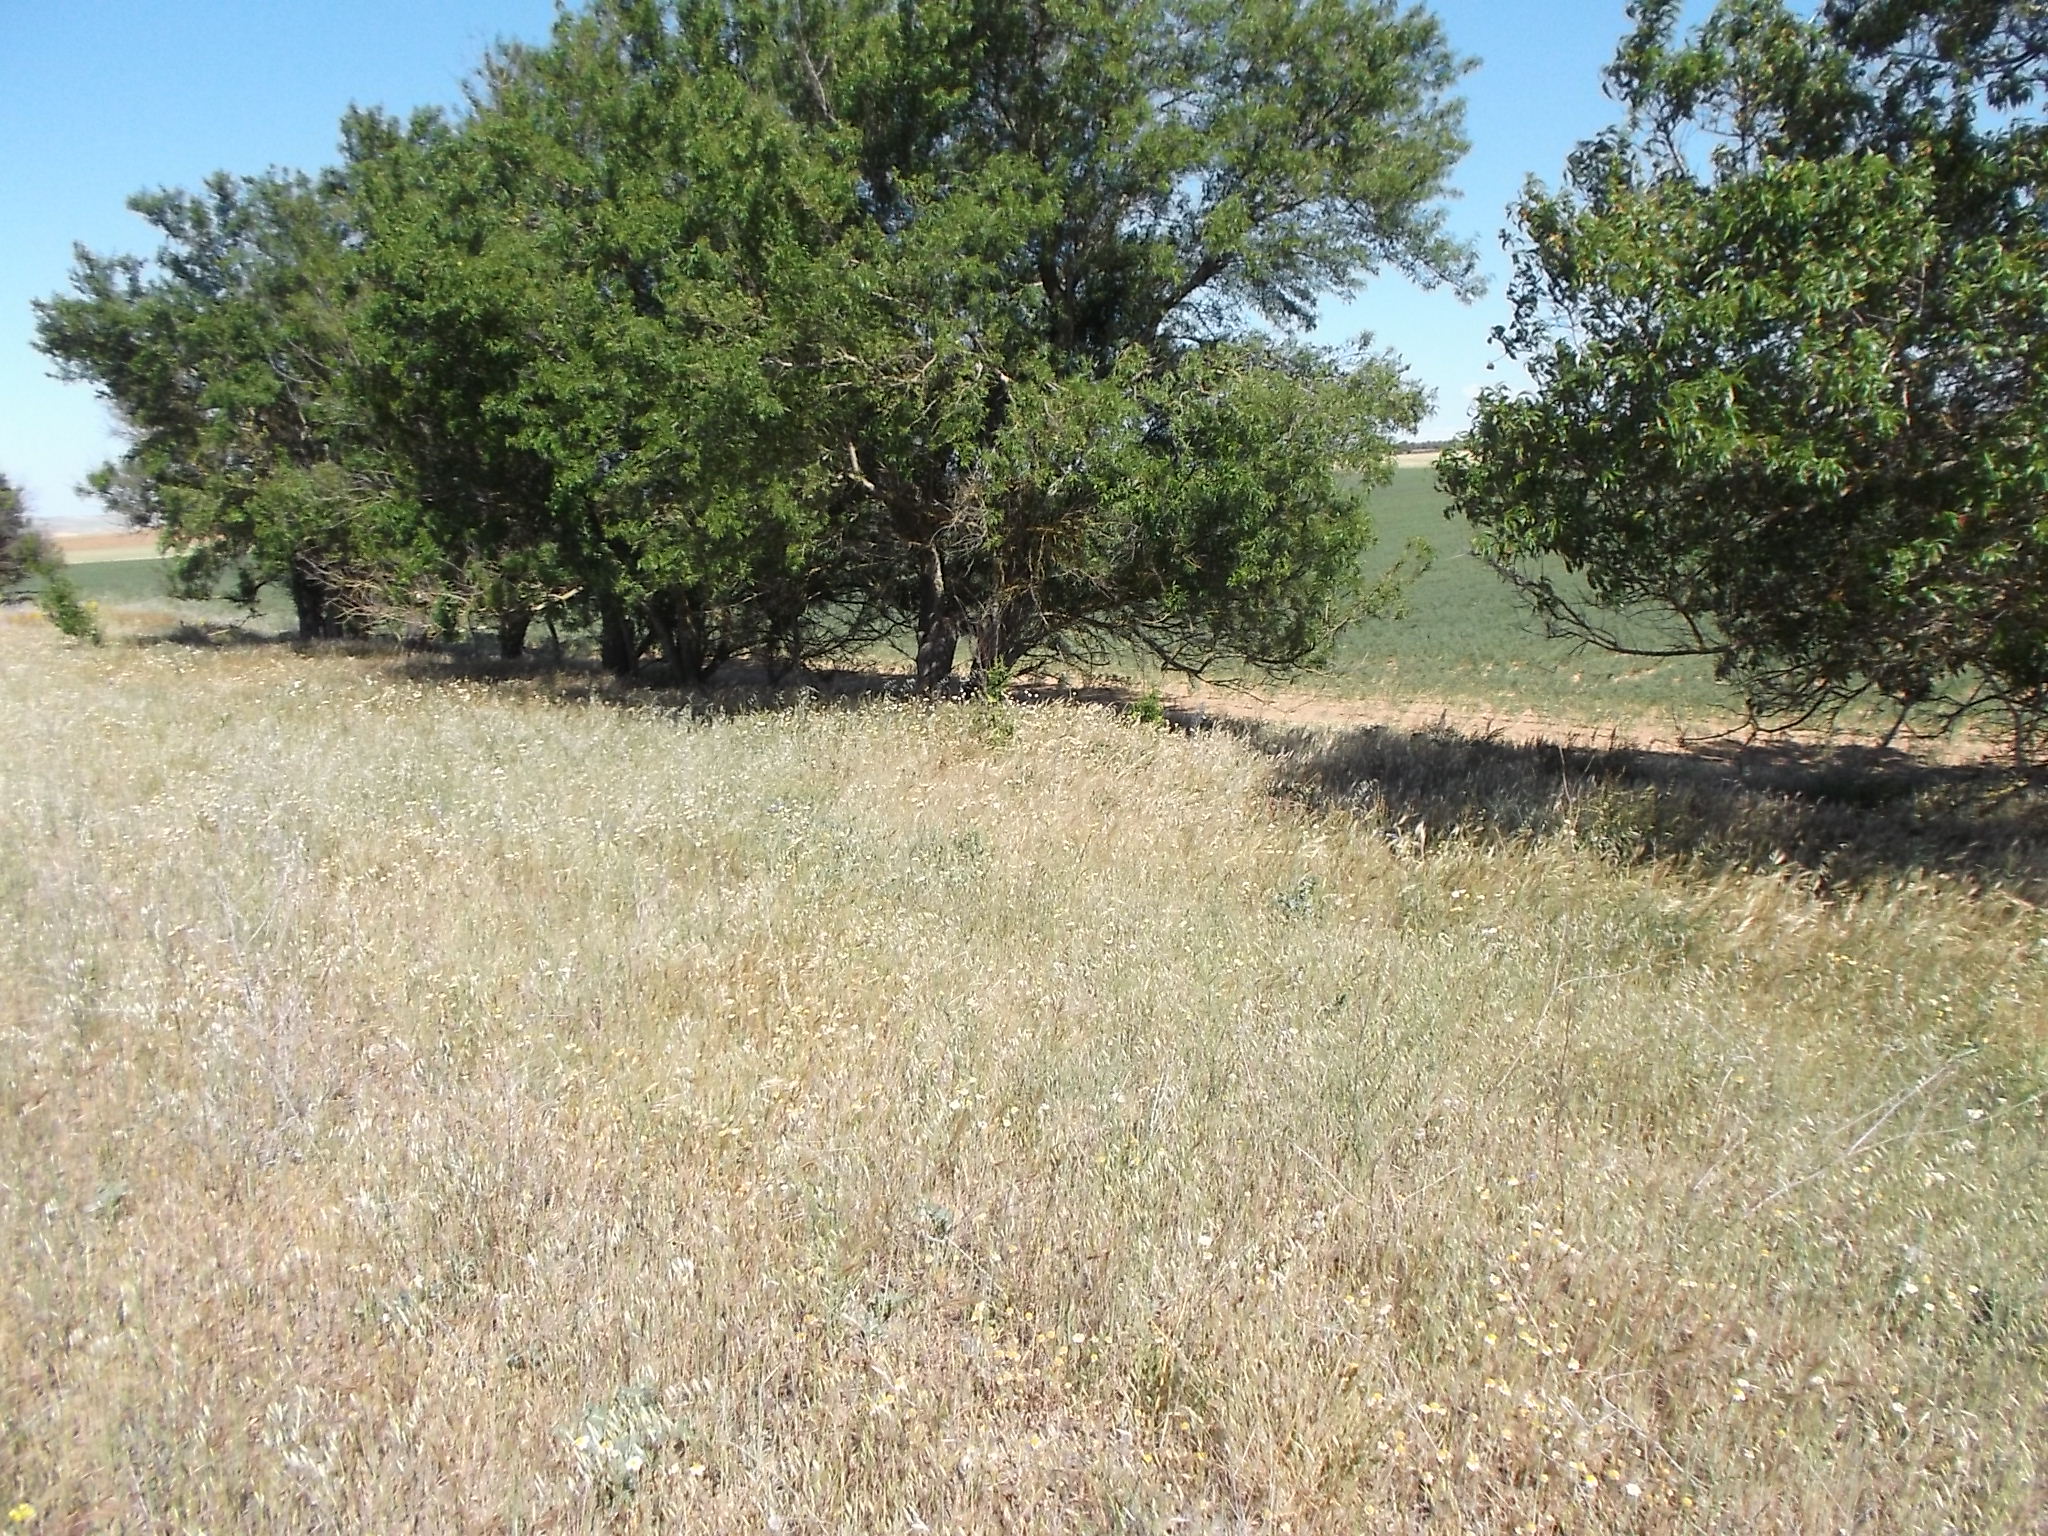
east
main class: Grassland
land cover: Grassland without tree/shrub cover
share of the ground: > 75 %
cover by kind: herbaceous plants 95 %, shrubs 5 %
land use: Abandoned areas
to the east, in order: Grassland without tree/shrub cover; Lines of trees; Ditches and canals; Grass margins; Dry pulses; Grass margins; Common wheat
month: May
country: ES
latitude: 41.2249
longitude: -5.4291
